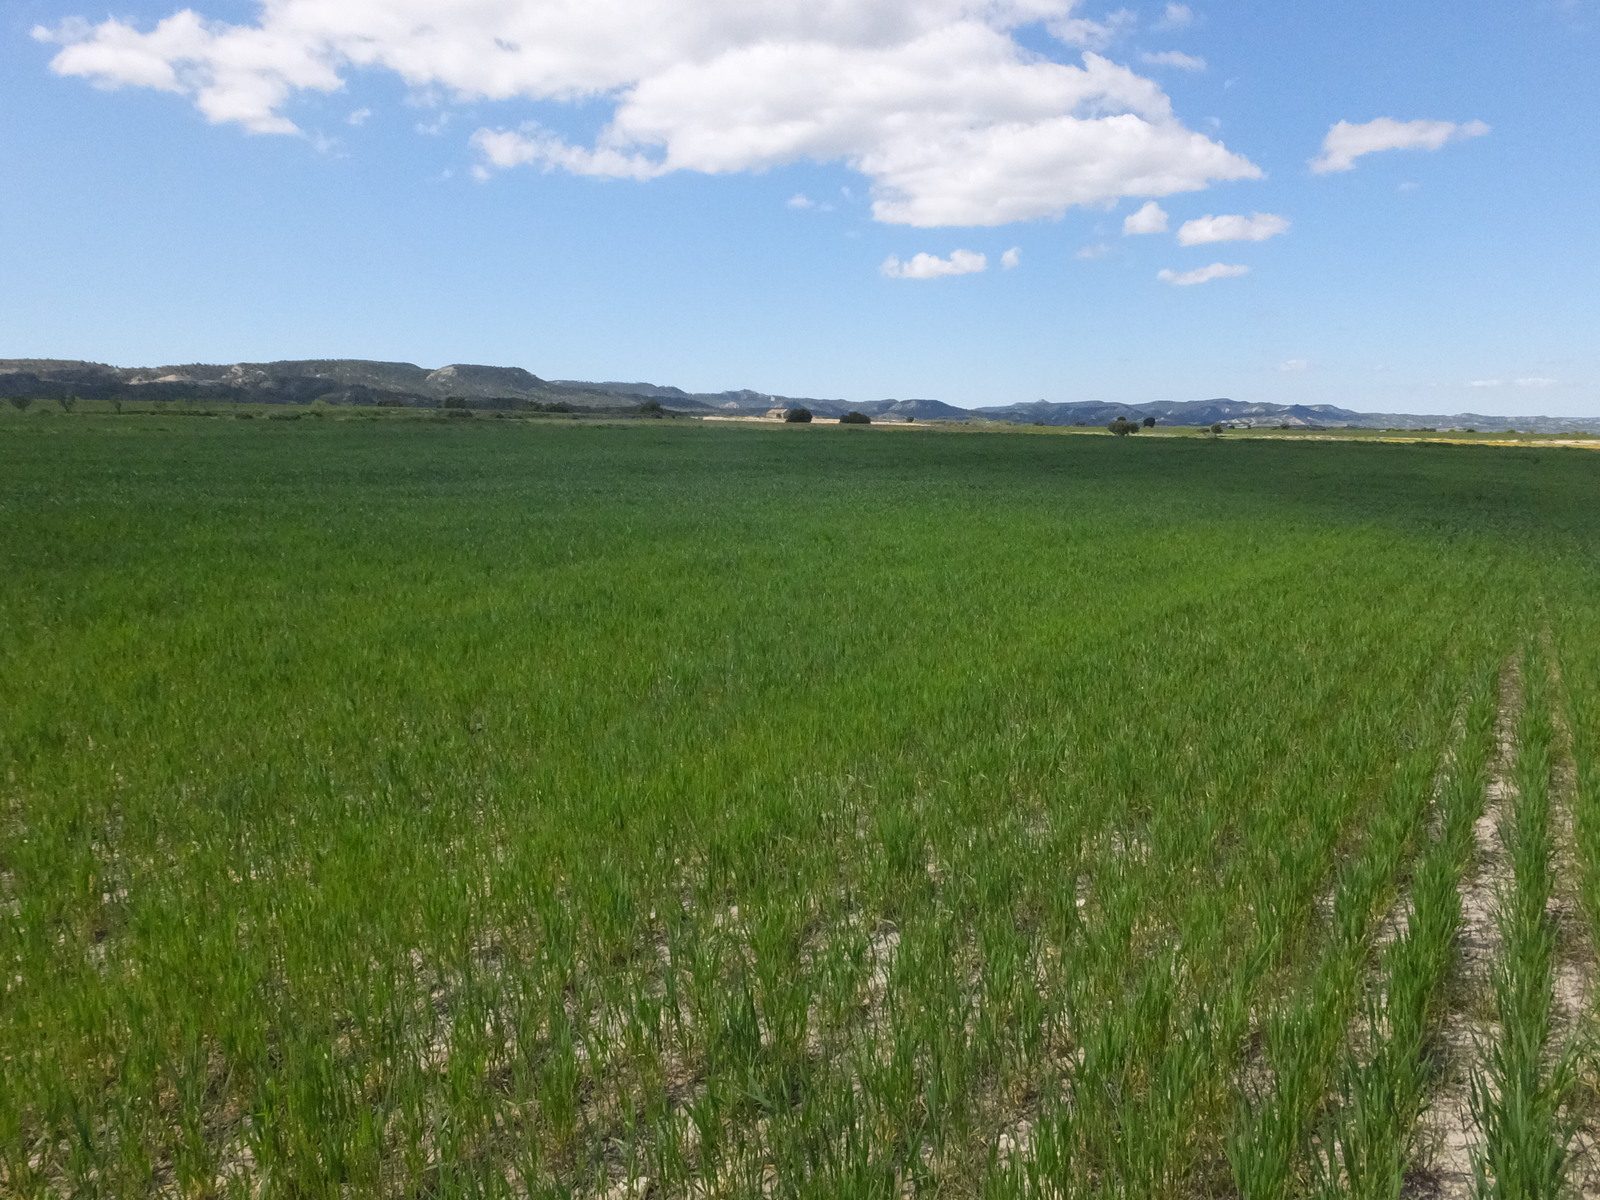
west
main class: Cropland
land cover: Barley
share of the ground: > 75 %
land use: Agriculture (excluding fallow land and kitchen gardens)
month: April
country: ES
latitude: 41.7072
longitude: -0.3176
